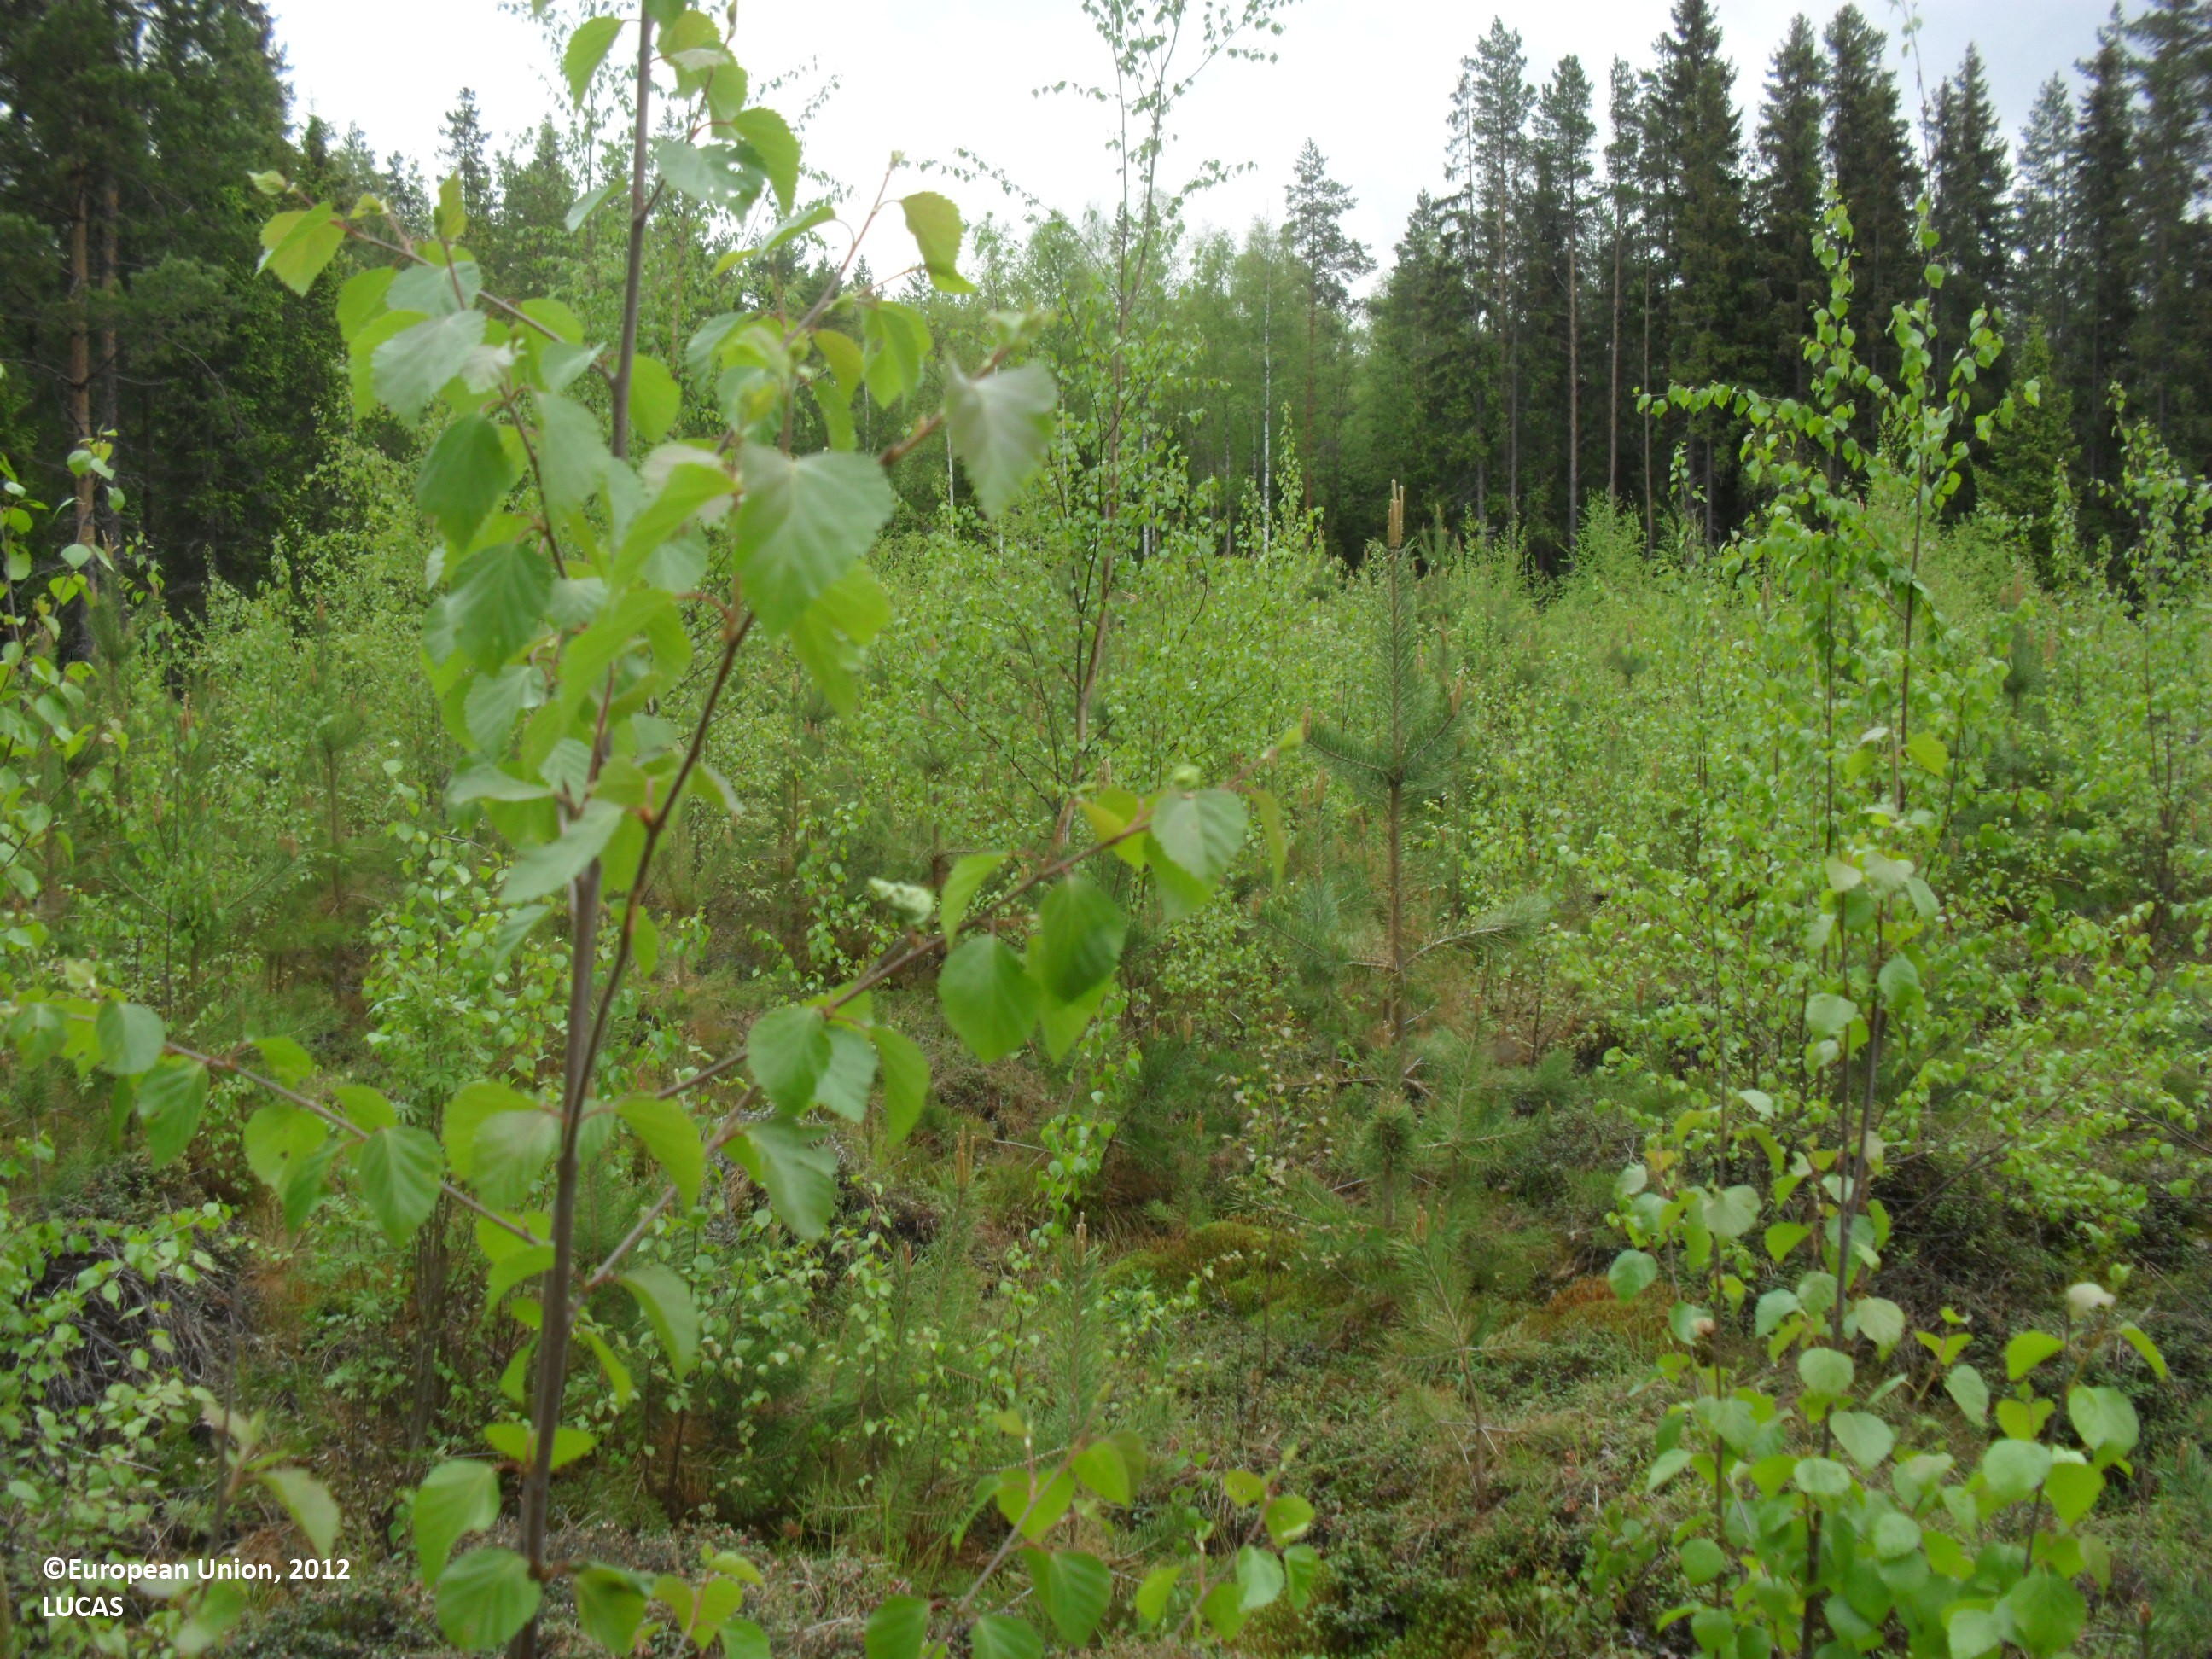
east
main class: Woodland
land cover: Pine dominated mixed woodland
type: boreal forest
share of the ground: < 10 %
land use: Forestry
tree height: < 5 m
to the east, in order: Pine dominated mixed woodland; Other mixed woodland; Spontaneously vegetated surfaces; Other mixed woodland; Broadleaved woodland; Spruce dominated coniferous woodland; Ditches and canals; Other mixed woodland; Ditches and canals; Spruce dominated mixed woodland; Other mixed woodland; Grassland with sparse tree/shrub cover; Other mixed woodland; Spruce dominated coniferous woodland; Broadleaved woodland
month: June
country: FI
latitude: 62.7953
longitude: 23.0207
